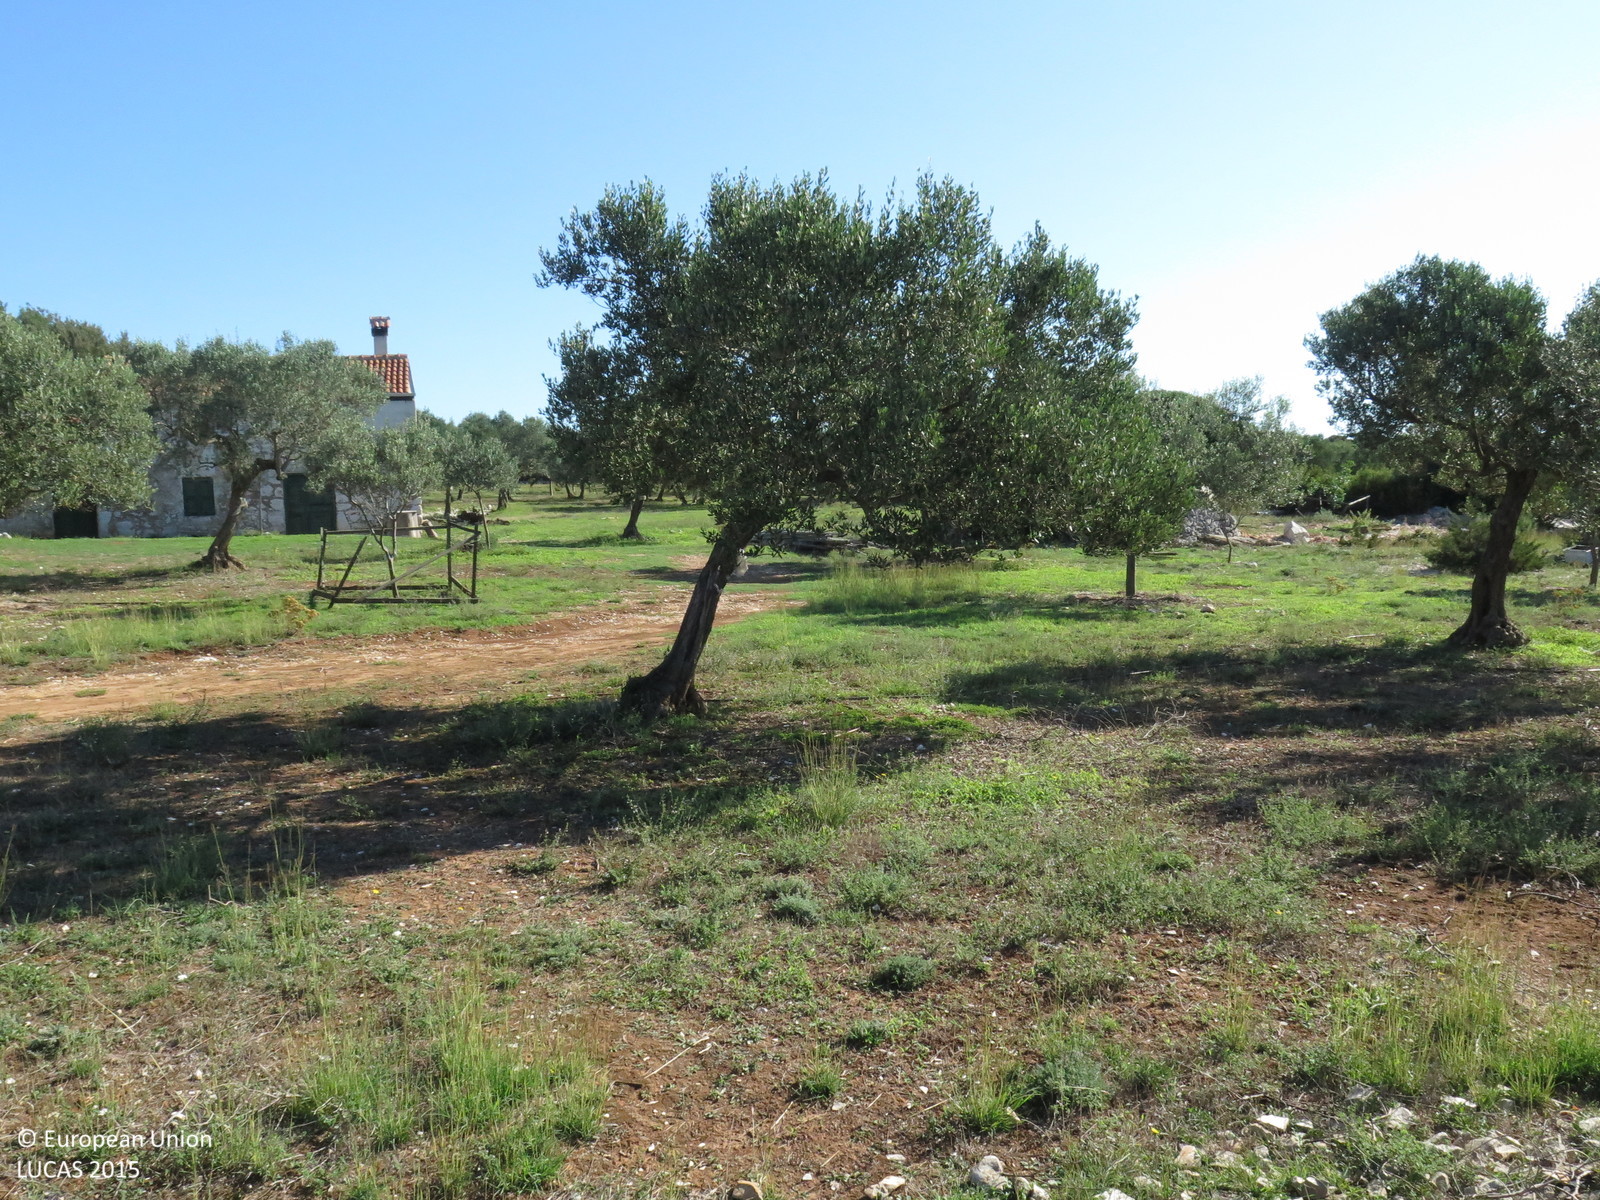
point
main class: Cropland
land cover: Olive groves
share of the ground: 25 - 50 %
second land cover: Grassland without tree/shrub cover
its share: > 75 %
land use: Agriculture (excluding fallow land and kitchen gardens)
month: September
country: HR
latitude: 44.5648
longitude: 14.3874
